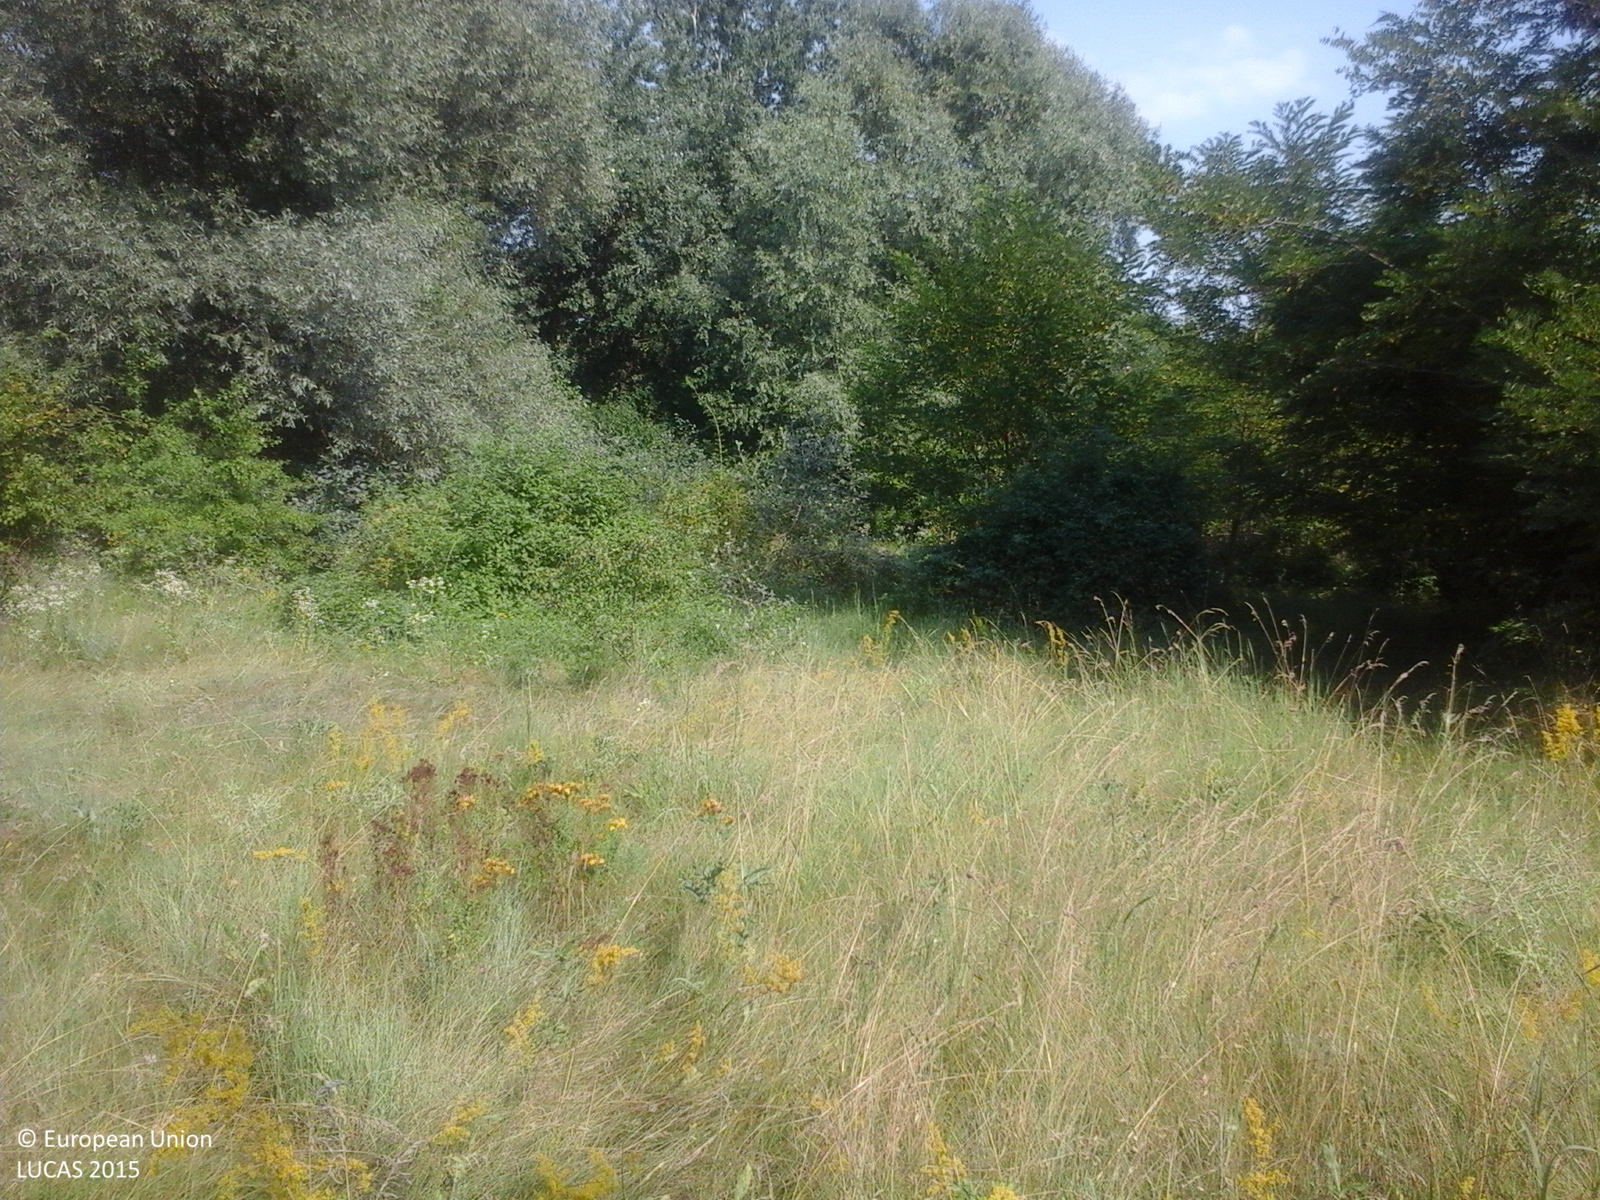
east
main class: Grassland
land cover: Grassland with sparse tree/shrub cover
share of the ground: > 75 %
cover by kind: herbaceous plants 85 %, shrubs 10 %, broadleaved forest trees 5 %
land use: Agriculture (excluding fallow land and kitchen gardens)
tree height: < 5 m
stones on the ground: < 10 %
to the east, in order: Grassland with sparse tree/shrub cover; Broadleaved woodland; Tracks; Spontaneously vegetated surfaces; Ditches and canals; Lines of trees; Spontaneously vegetated surfaces; Tracks; Spontaneously vegetated surfaces; Tracks; Broadleaved woodland; Spontaneously vegetated surfaces; Maize
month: July
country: RO
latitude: 44.6611
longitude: 25.3889
